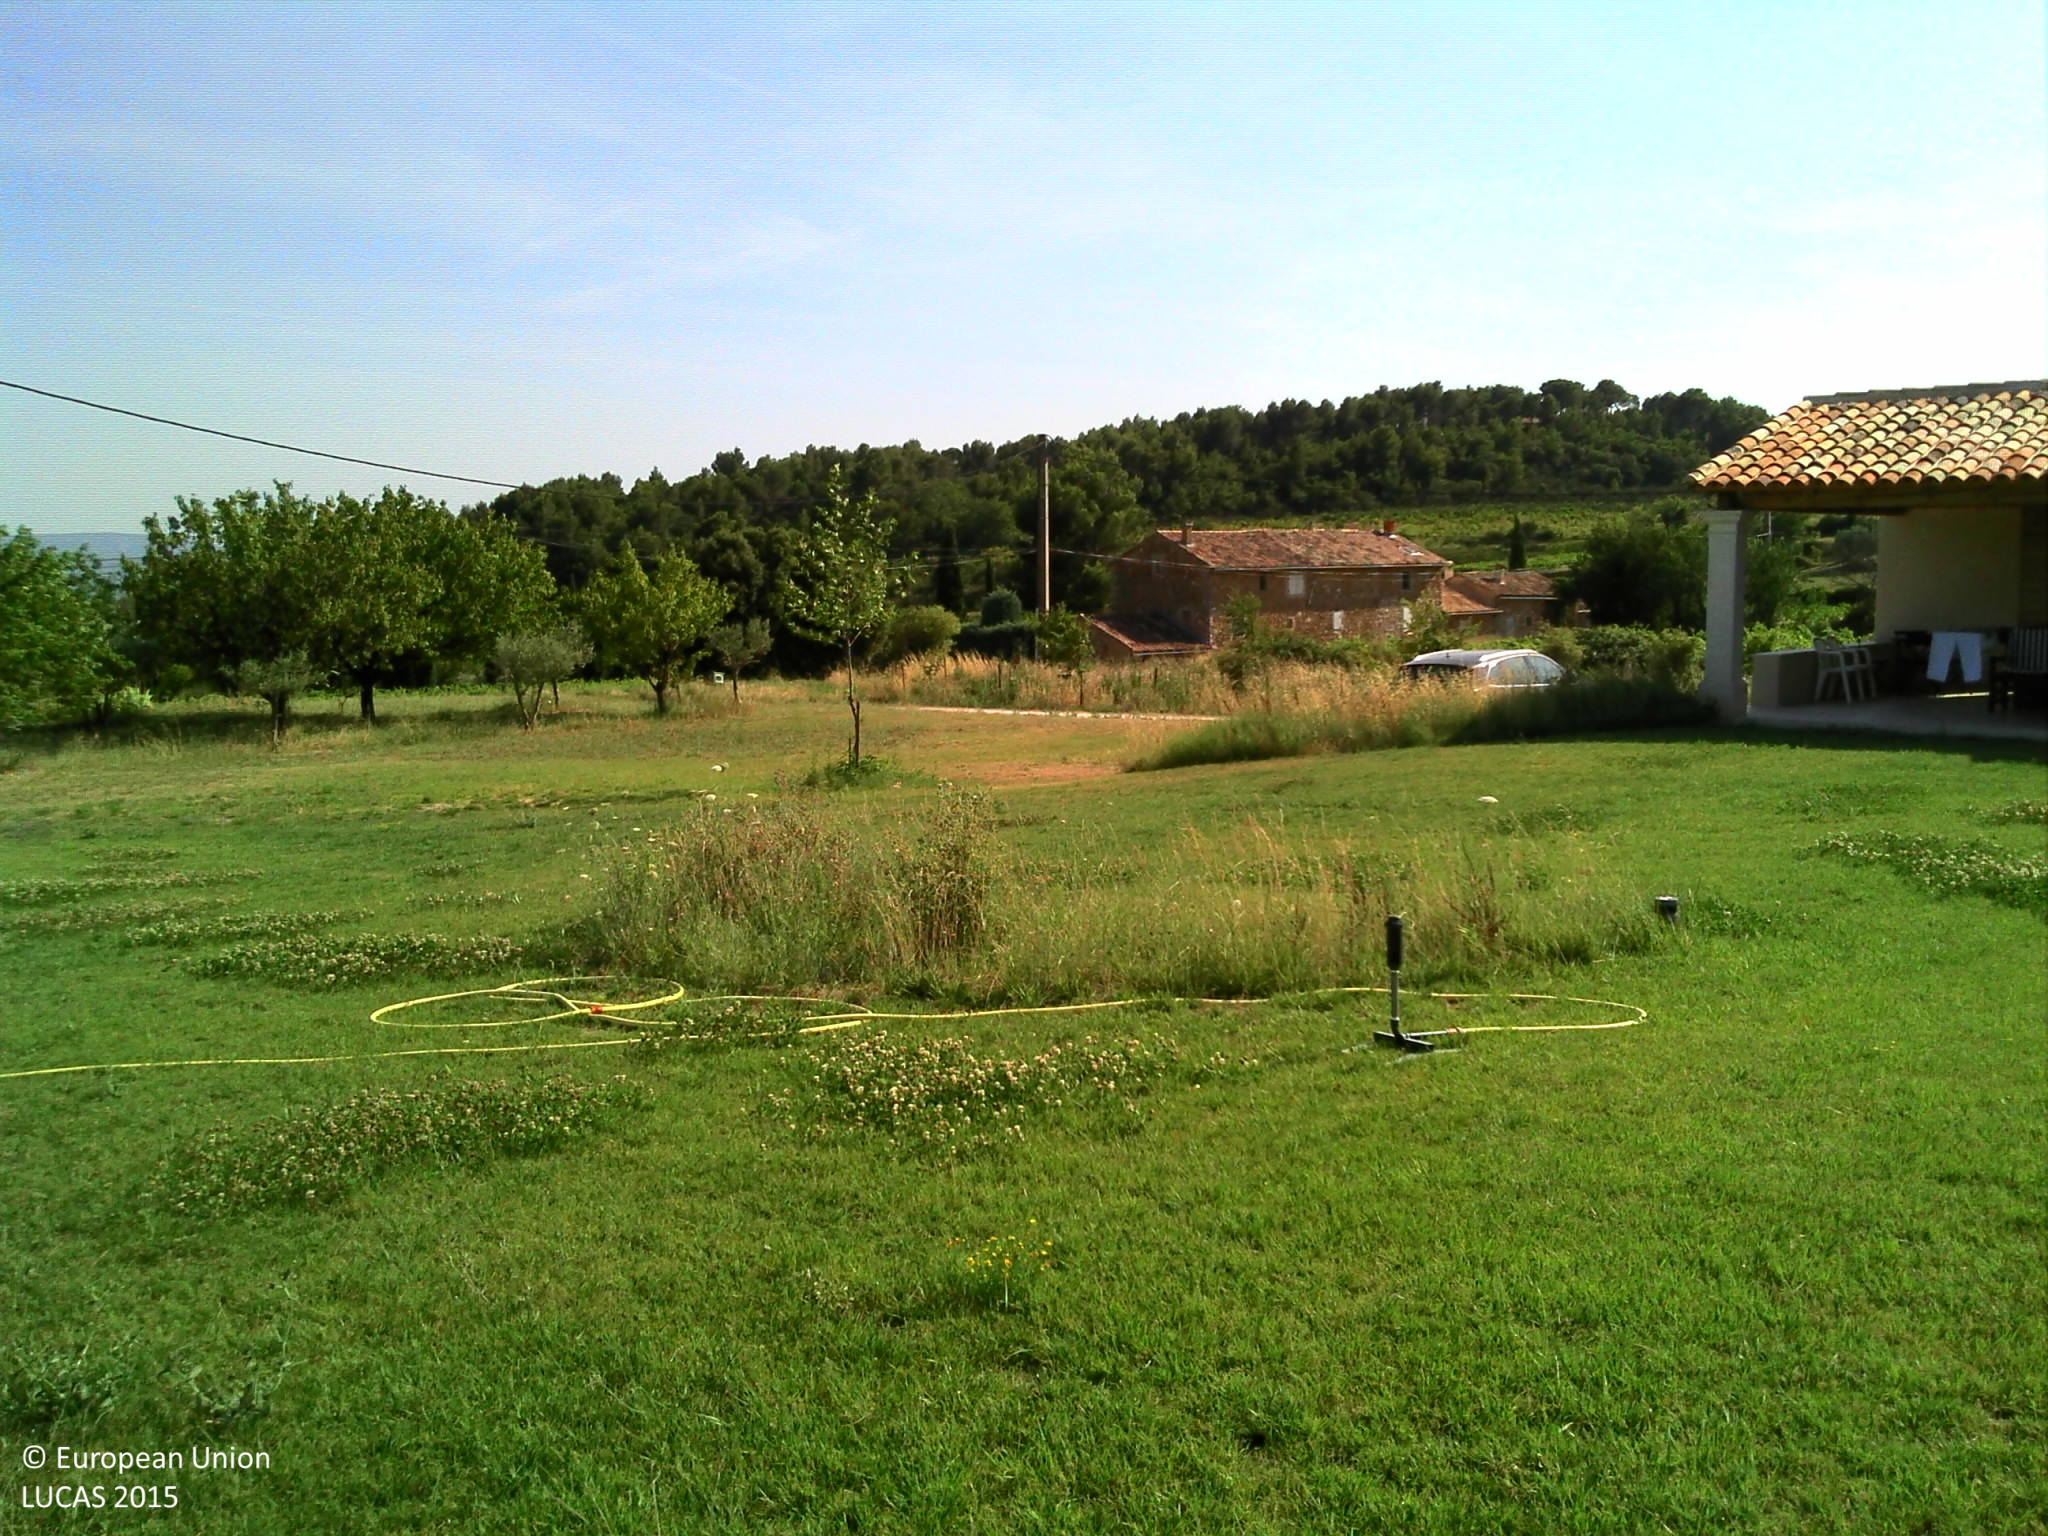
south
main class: Grassland
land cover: Grassland without tree/shrub cover
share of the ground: > 75 %
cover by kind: herbaceous plants 100 %
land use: Residential
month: July
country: FR
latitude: 44.1443
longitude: 5.0950
